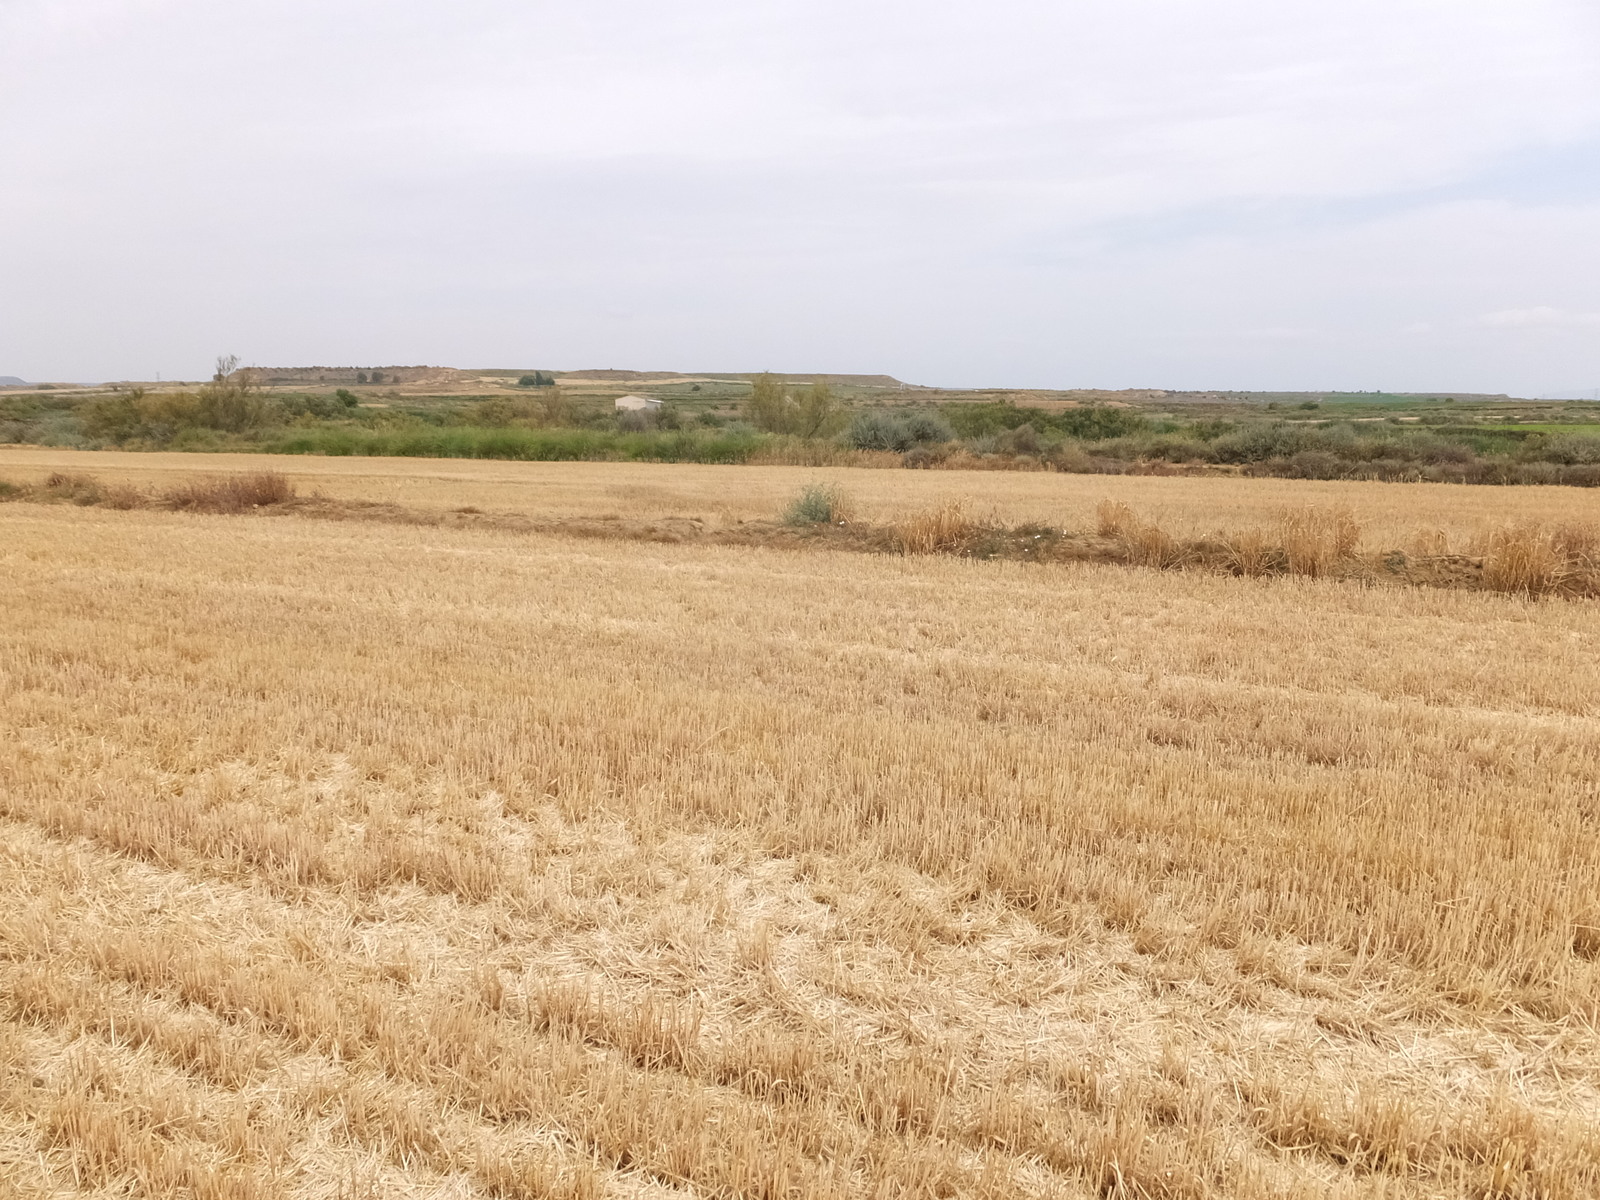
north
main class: Cropland
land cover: Barley
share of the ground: < 10 %
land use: Agriculture (excluding fallow land and kitchen gardens)
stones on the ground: < 10 %
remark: Harvested field
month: June
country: ES
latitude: 41.7662
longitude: 0.0839
